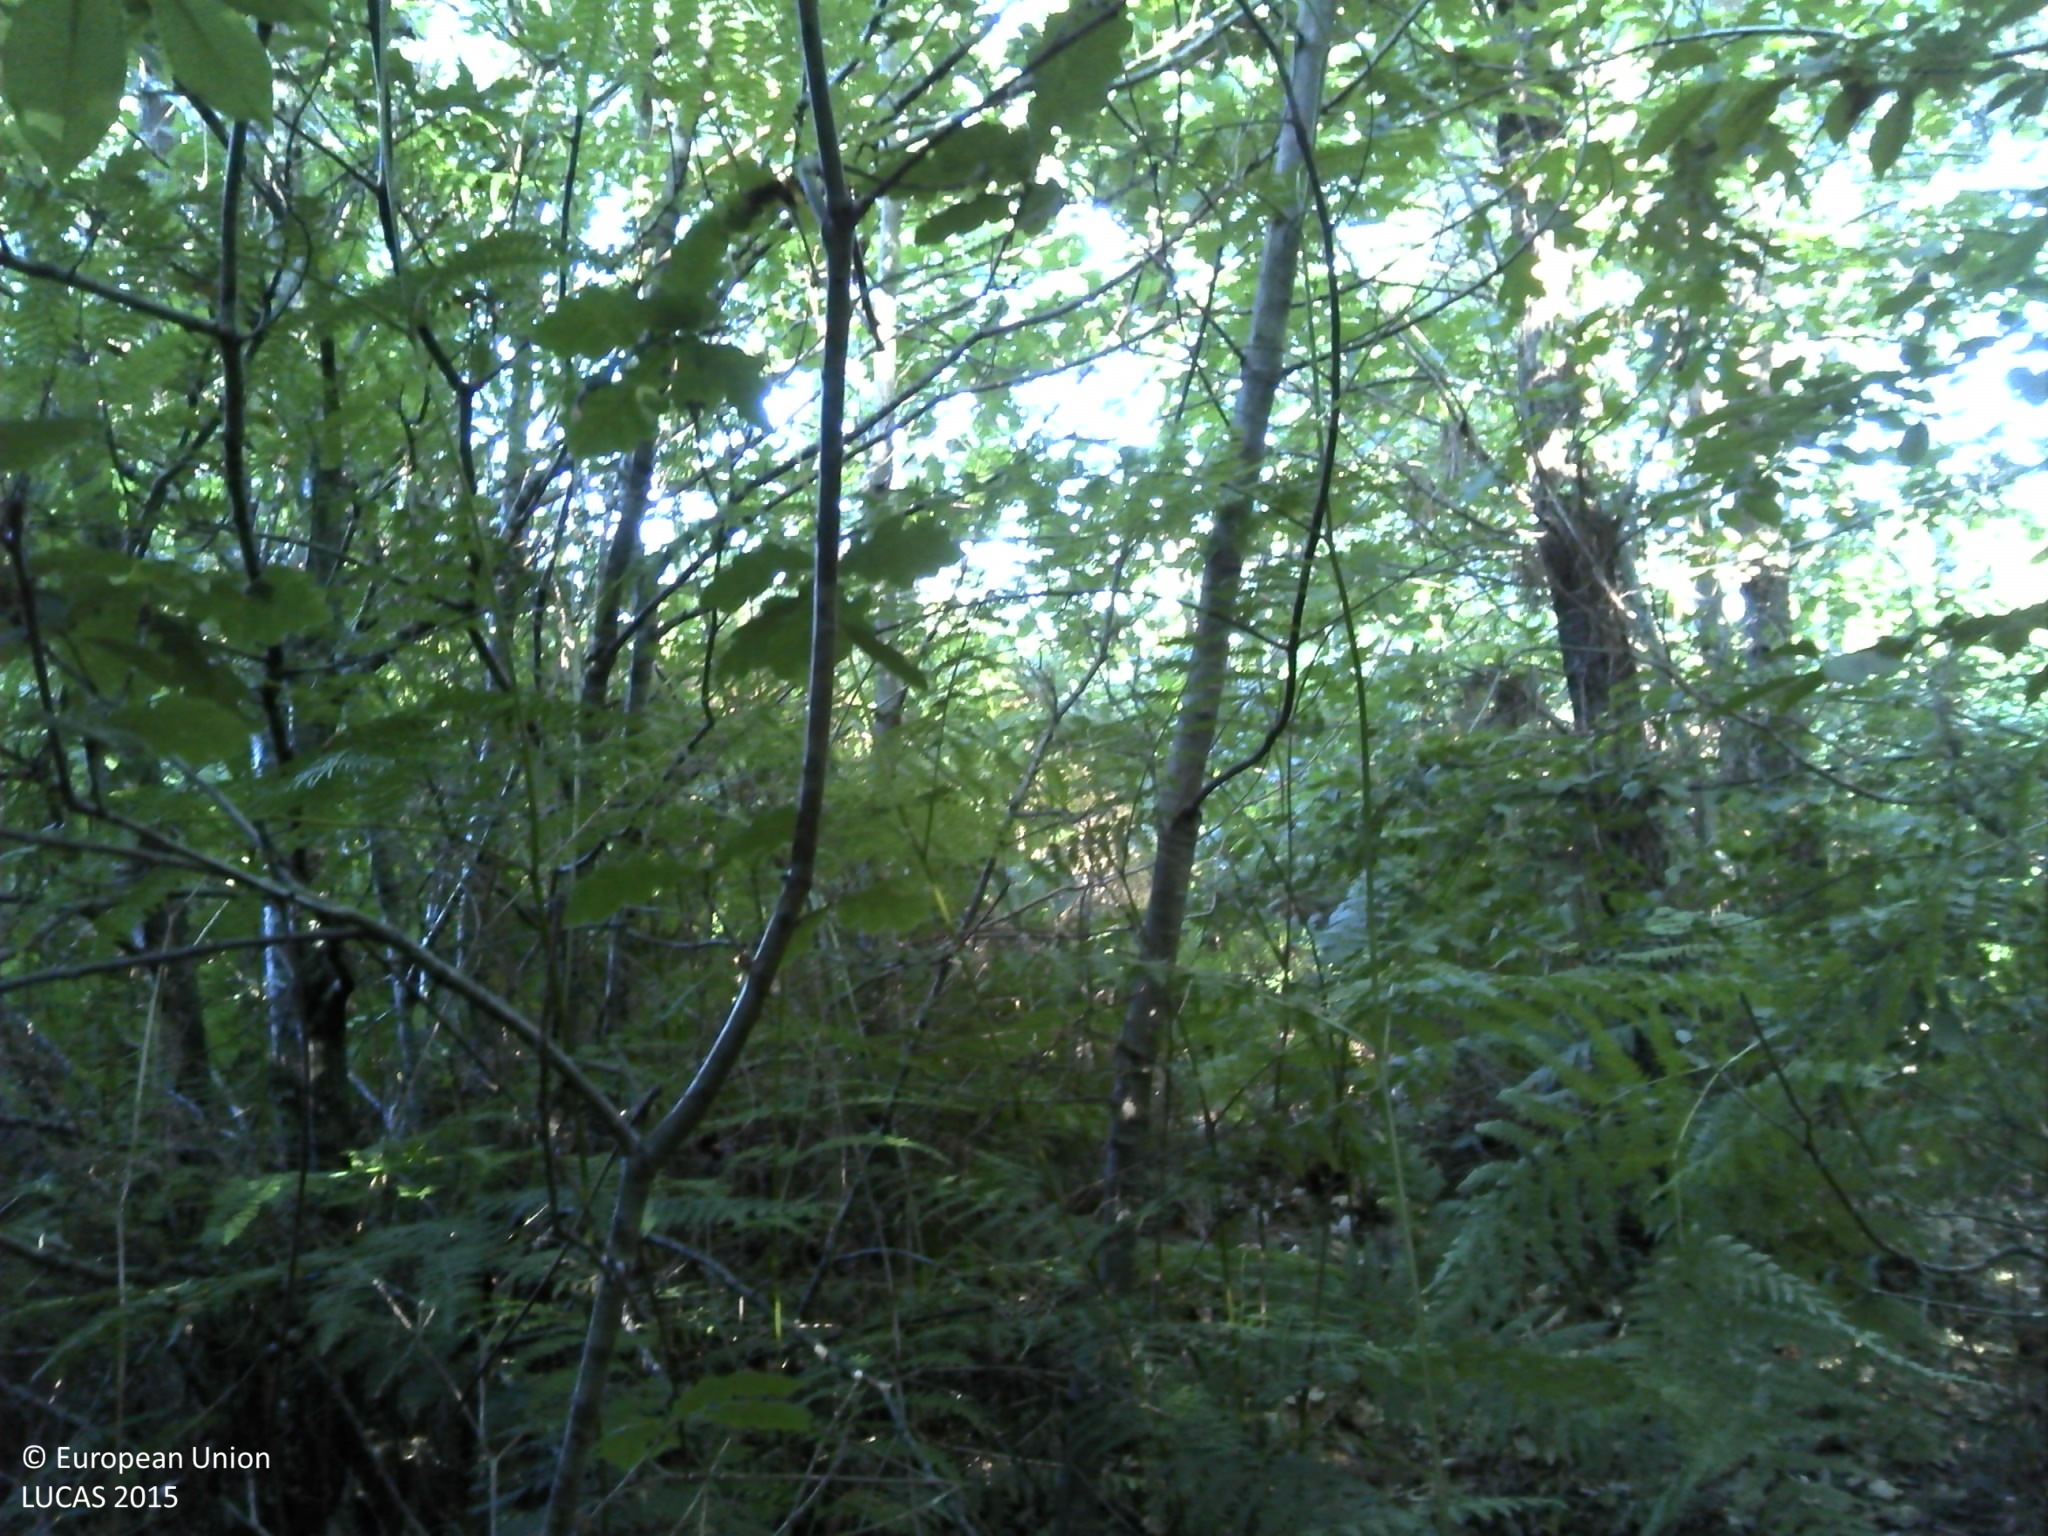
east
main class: Woodland
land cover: Pine dominated mixed woodland
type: coniferous forest of the mediterranean region
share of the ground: > 75 %
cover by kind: coniferous forest trees 50 %, broadleaved forest trees 25 %, shrubs 25 %
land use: Forestry
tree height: > 5 m
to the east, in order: Pine dominated mixed woodland; Tracks; Pine dominated mixed woodland; Rivers and streams; Pine dominated coniferous woodland
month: July
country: FR
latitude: 44.9635
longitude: -0.6567
